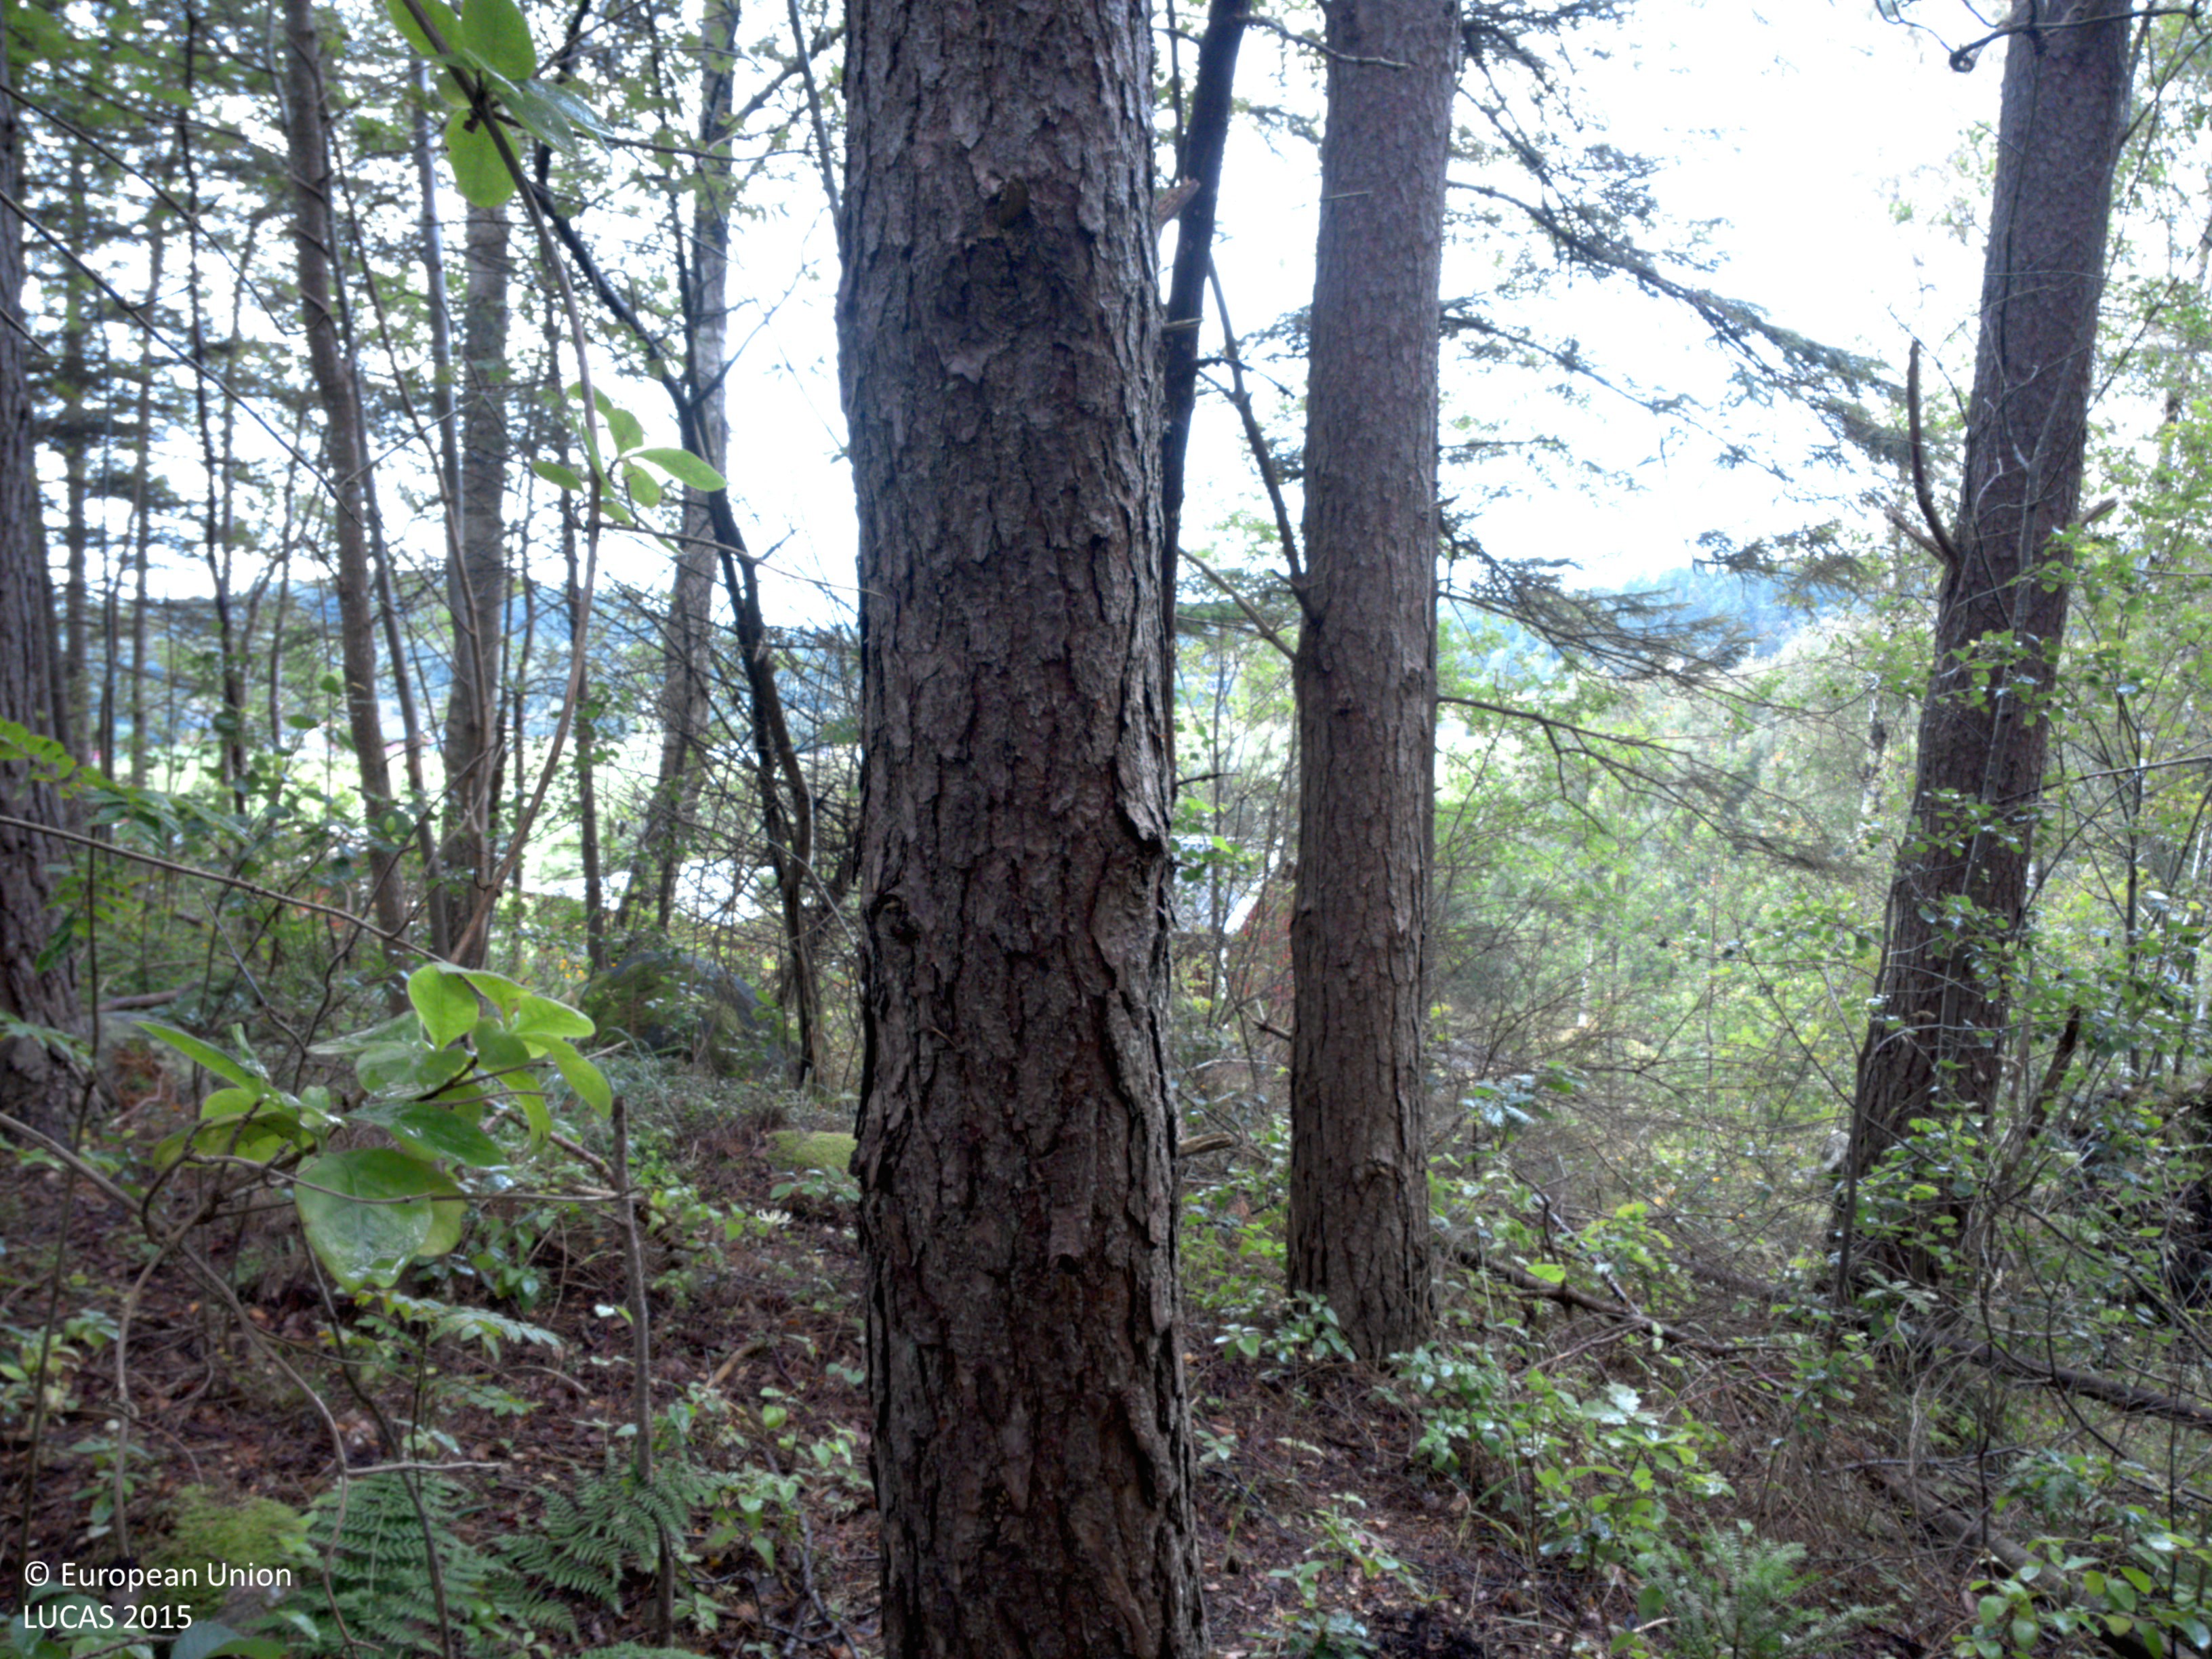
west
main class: Woodland
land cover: Pine dominated mixed woodland
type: boreal forest
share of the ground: 50 - 75 %
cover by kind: coniferous forest trees 35 %, broadleaved forest trees 25 %, herbaceous plants 20 %, consolidated bare surface 20 %
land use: Semi-natural and natural areas not in use
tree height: > 5 m
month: July
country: SE
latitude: 58.0643
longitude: 11.7425
